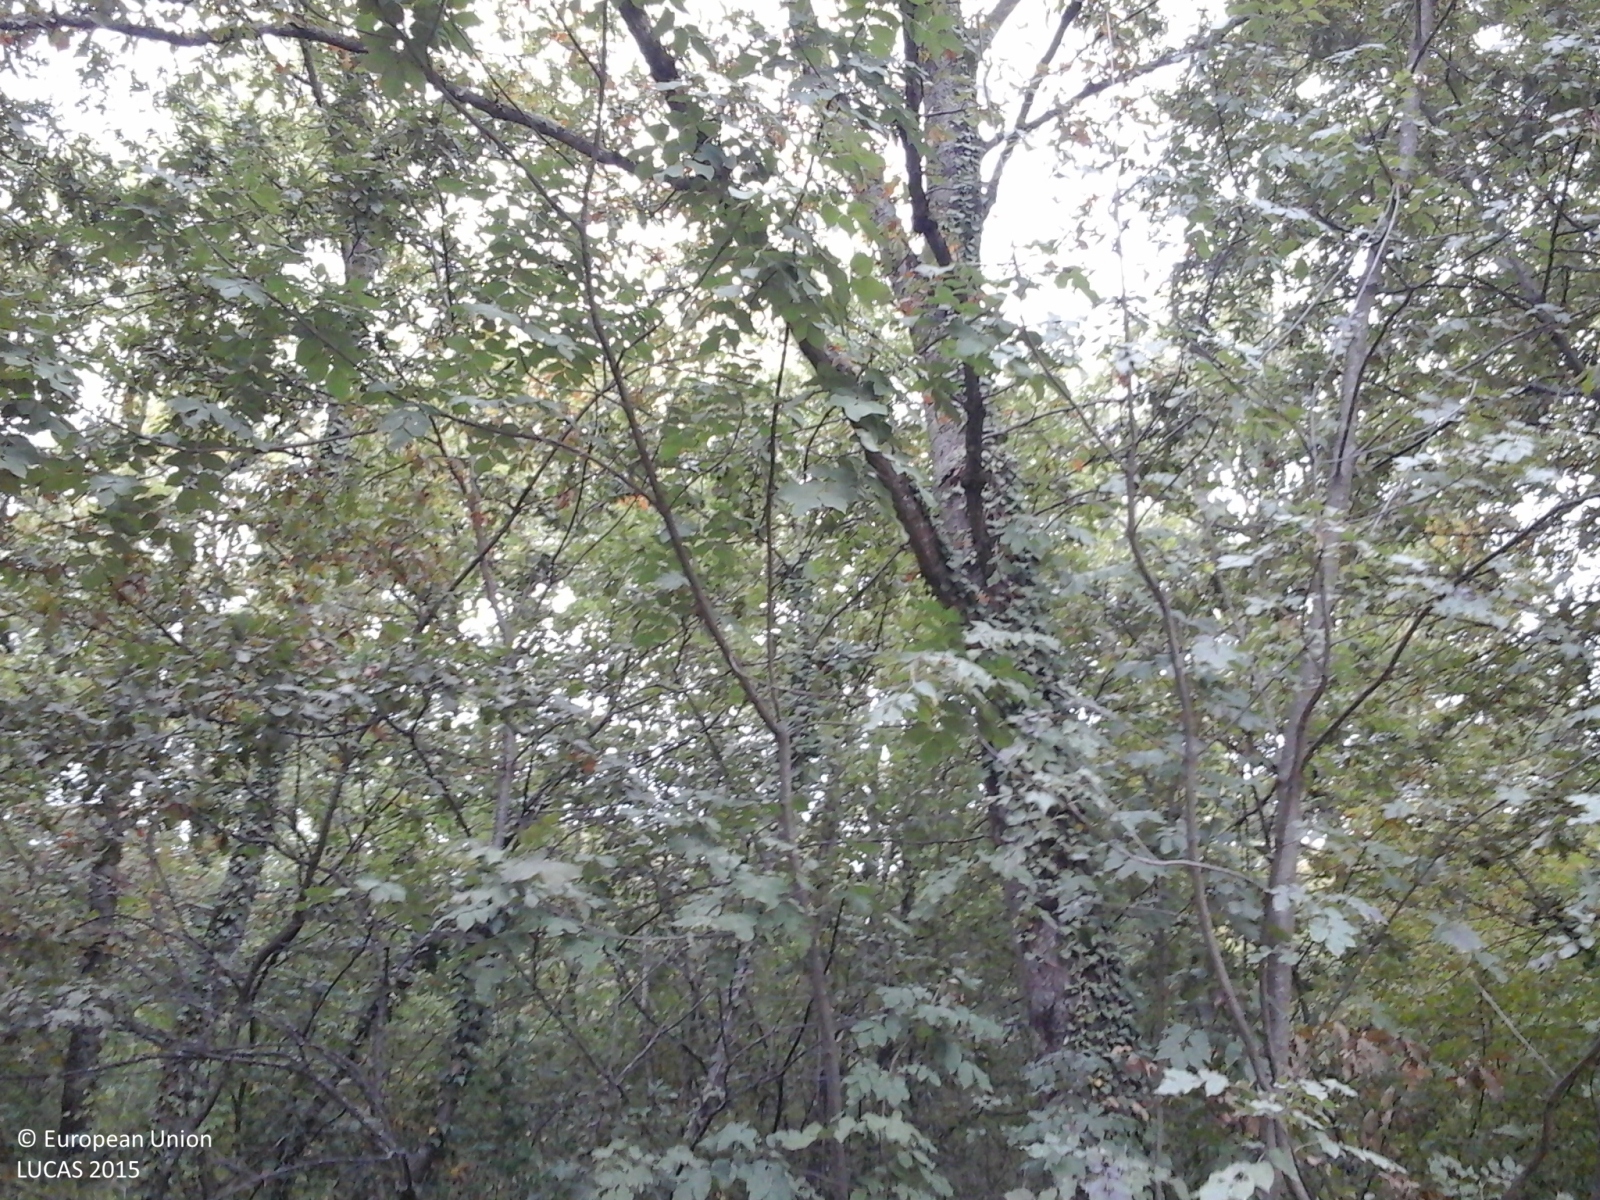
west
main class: Woodland
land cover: Broadleaved woodland
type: thermophilous deciduous forest
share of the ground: > 75 %
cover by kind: broadleaved forest trees 85 %, shrubs 10 %, herbaceous plants 5 %
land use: Forestry
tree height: > 5 m
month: October
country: IT
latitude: 43.1863
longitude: 12.3679
